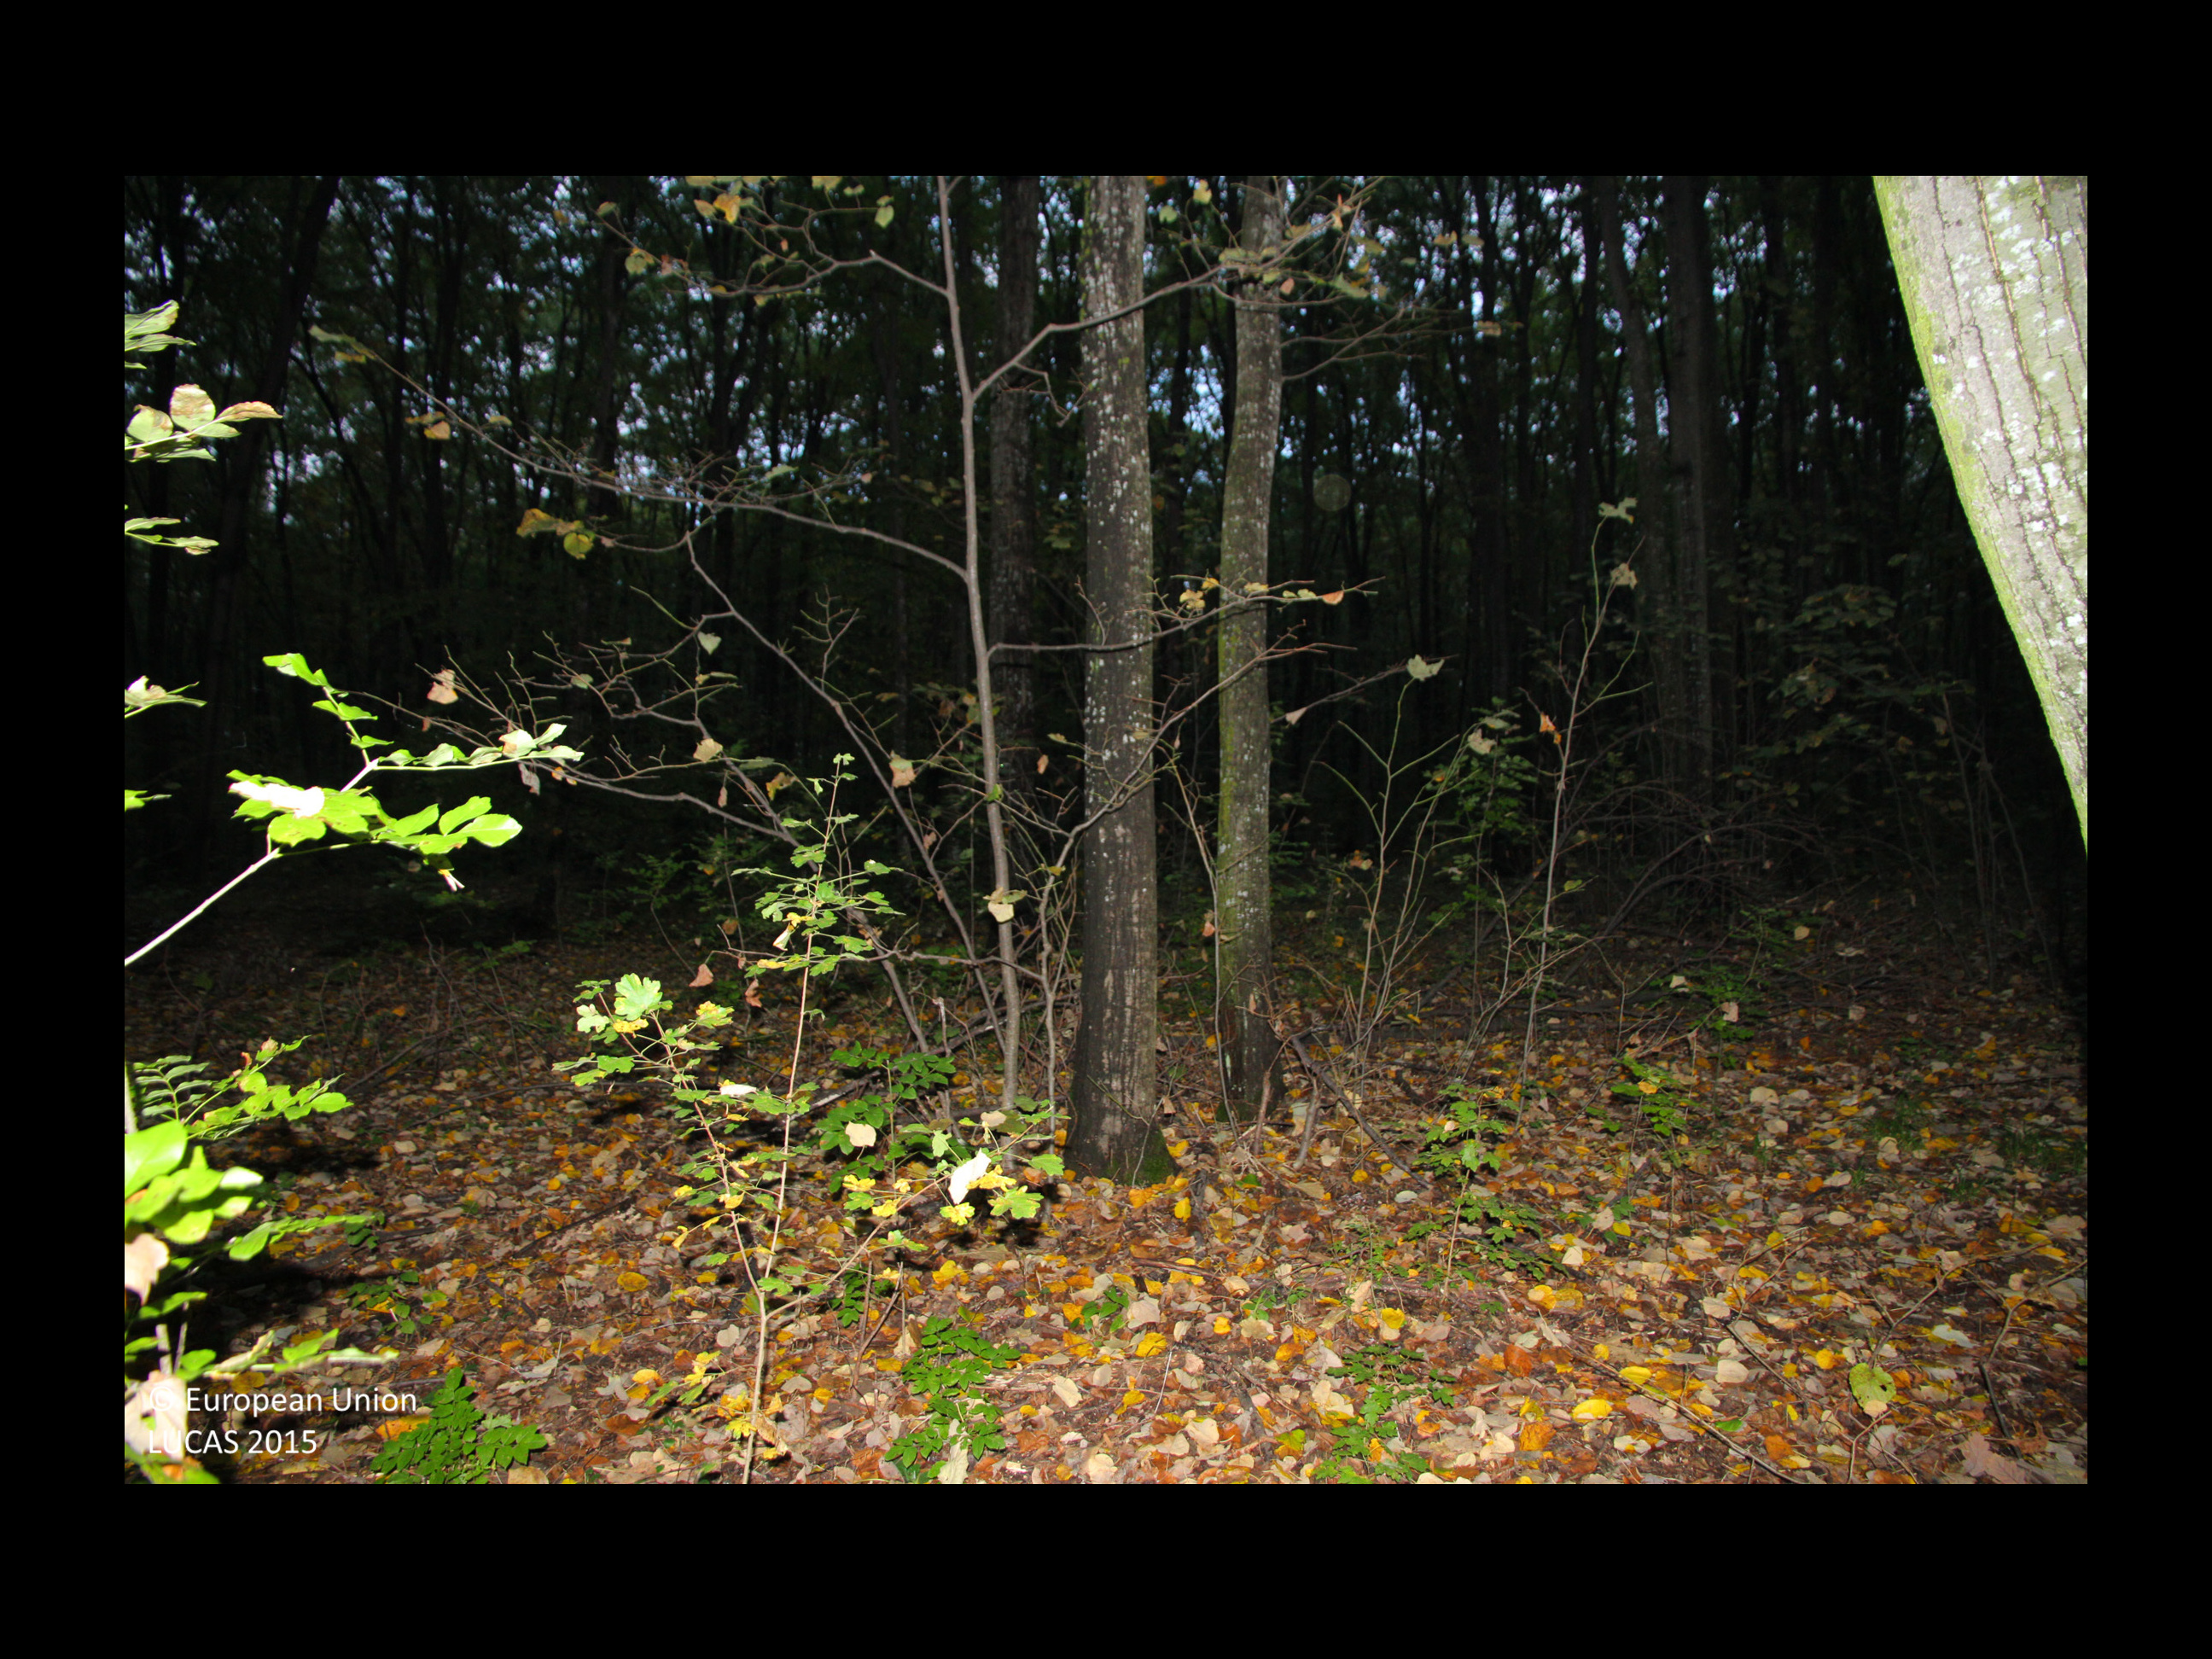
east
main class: Woodland
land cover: Broadleaved woodland
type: beech forest
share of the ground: > 75 %
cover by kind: broadleaved forest trees 100 %
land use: Forestry
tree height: > 5 m
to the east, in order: Broadleaved woodland
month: October
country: BG
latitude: 43.4375
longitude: 26.5239
